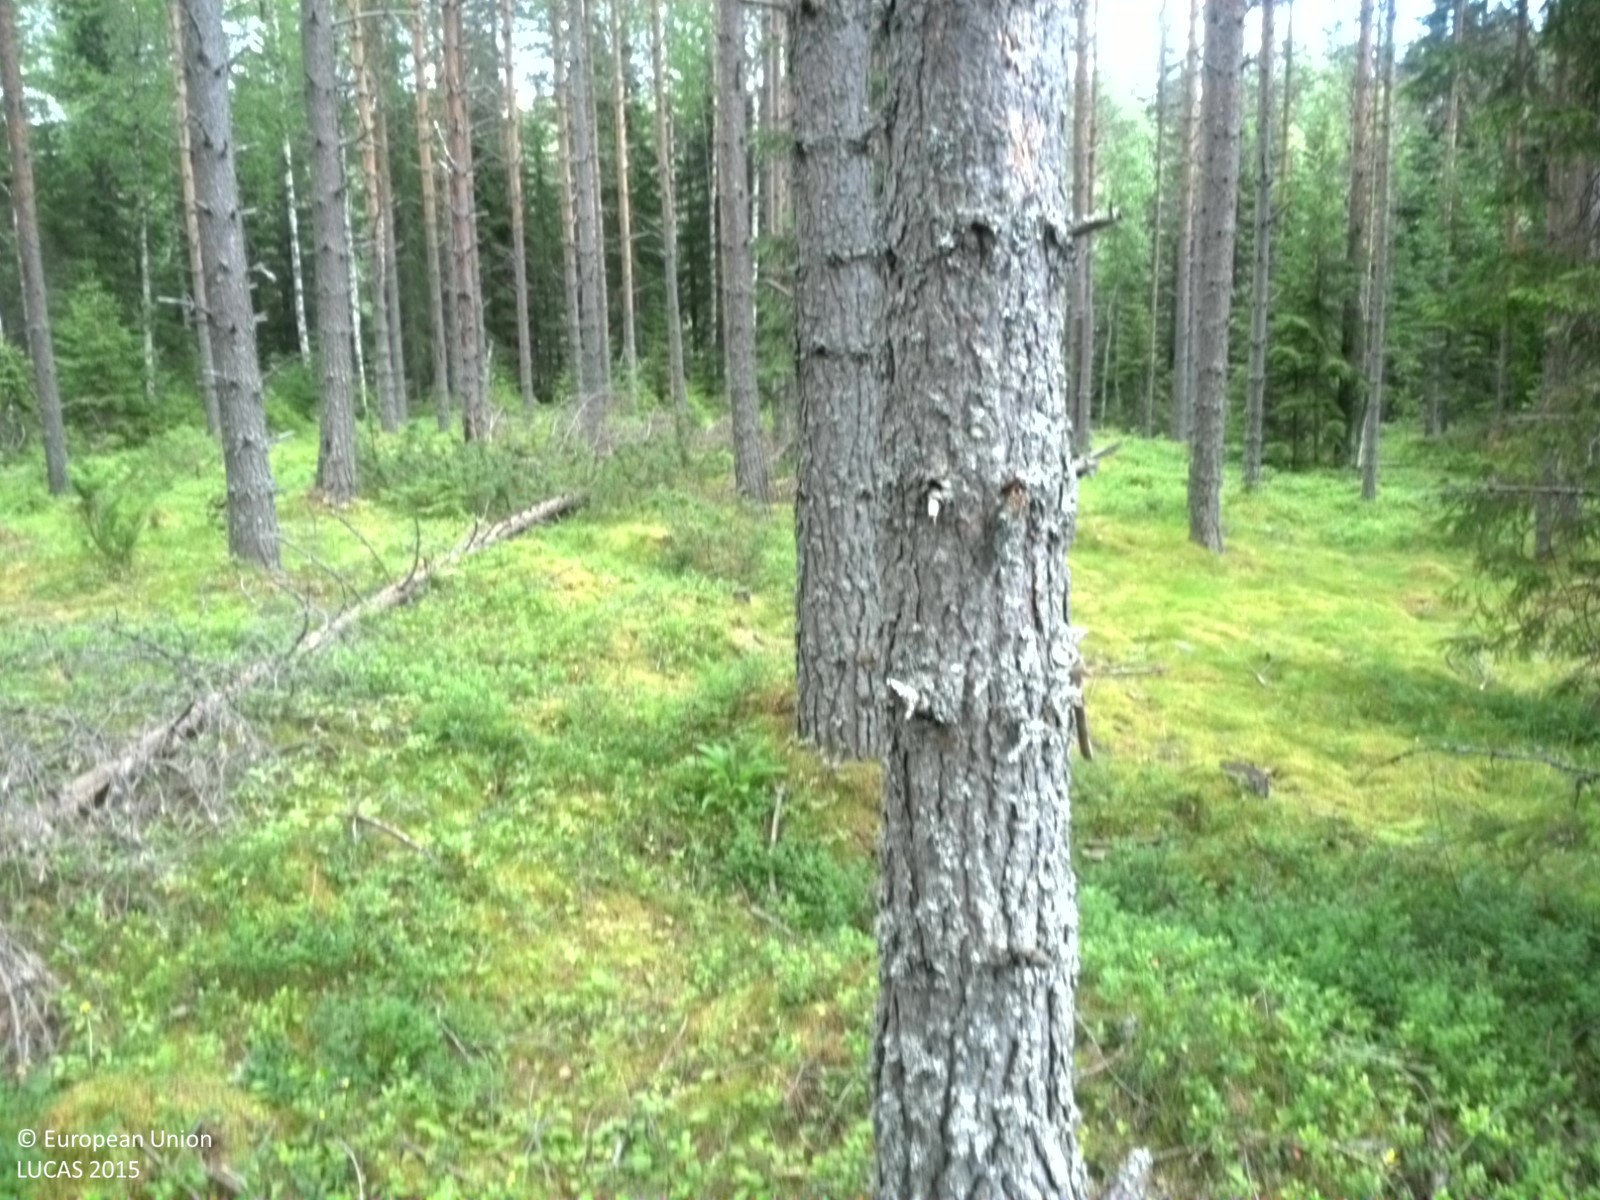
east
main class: Woodland
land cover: Pine dominated coniferous woodland
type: boreal forest
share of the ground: 50 - 75 %
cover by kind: coniferous forest trees 65 %, shrubs 20 %, broadleaved forest trees 10 %, herbaceous plants 5 %
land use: Forestry
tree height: > 5 m
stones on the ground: < 10 %
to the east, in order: Pine dominated coniferous woodland; Pine dominated mixed woodland; Peatbogs; Inland fresh water bodies; Peatbogs; Spruce dominated mixed woodland; Spruce dominated coniferous woodland; Other coniferous woodland; Pine dominated coniferous woodland
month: July
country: SE
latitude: 63.7093
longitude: 19.5502
